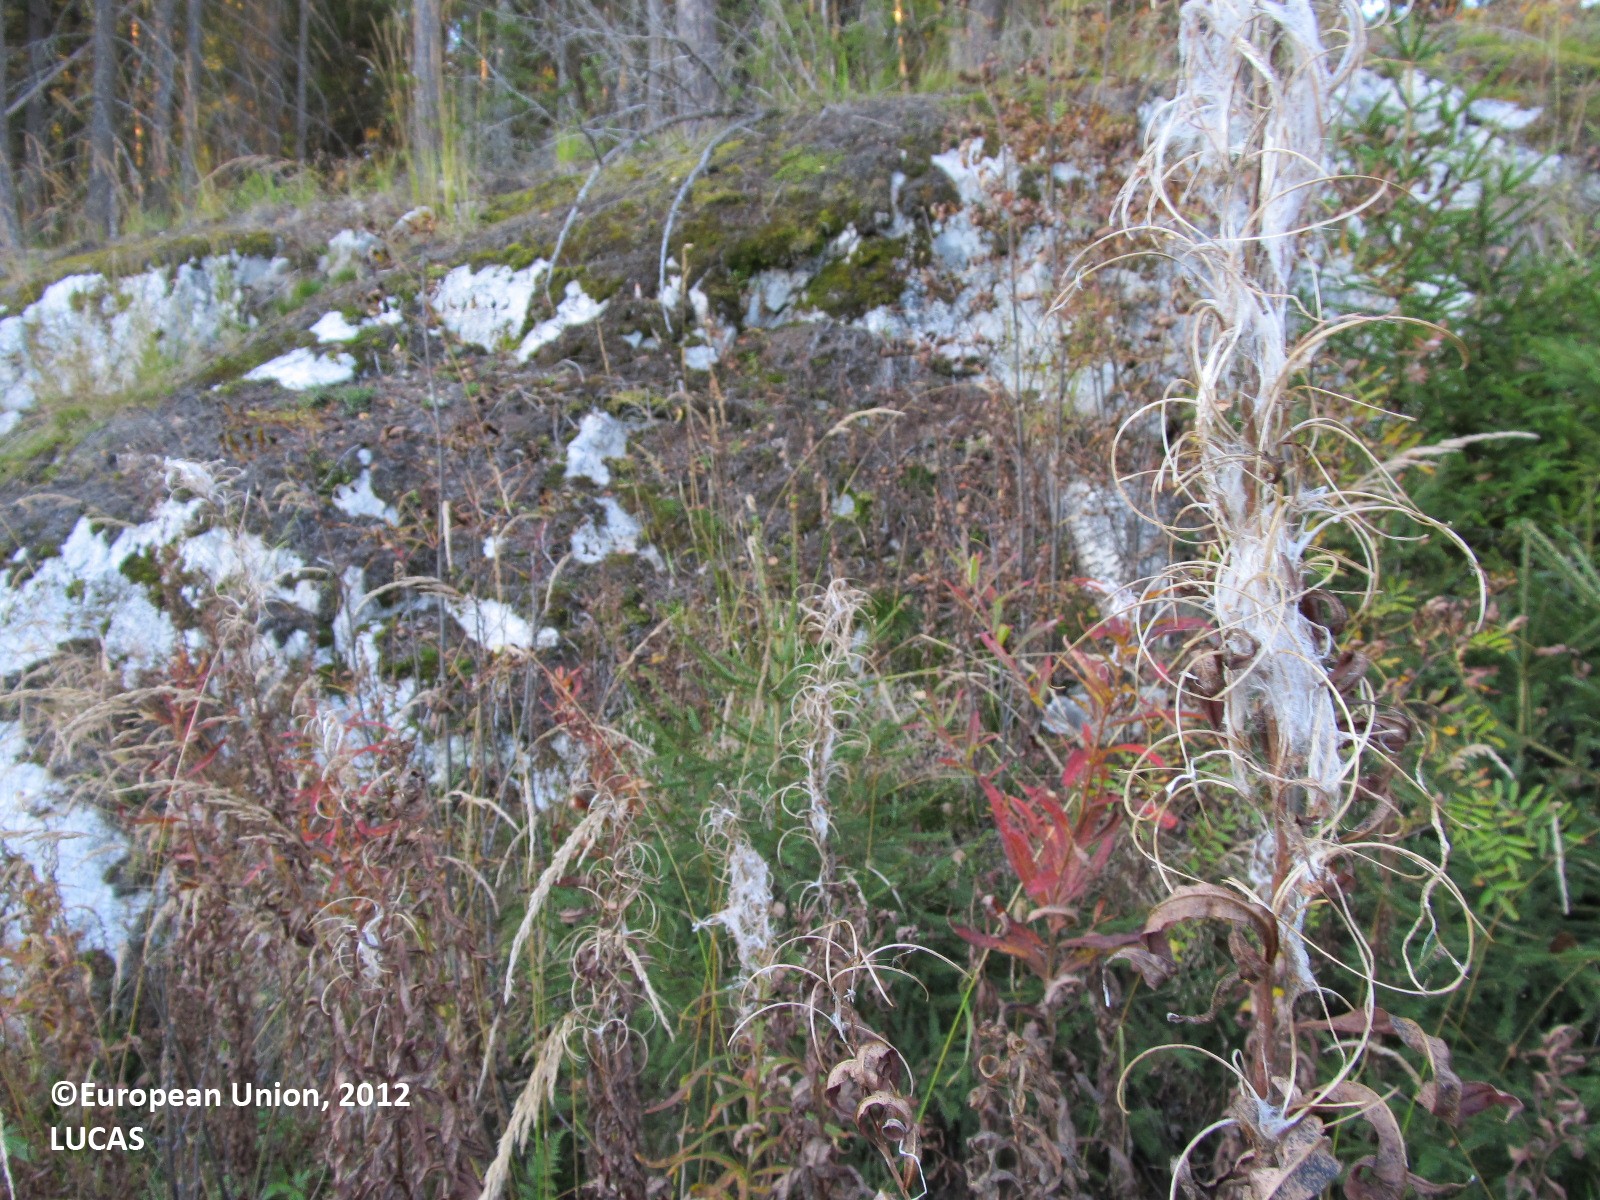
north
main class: Woodland
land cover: Broadleaved woodland
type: boreal forest
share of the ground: 25 - 50 %
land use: Forestry
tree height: > 5 m
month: September
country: FI
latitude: 62.3991
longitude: 28.6455
